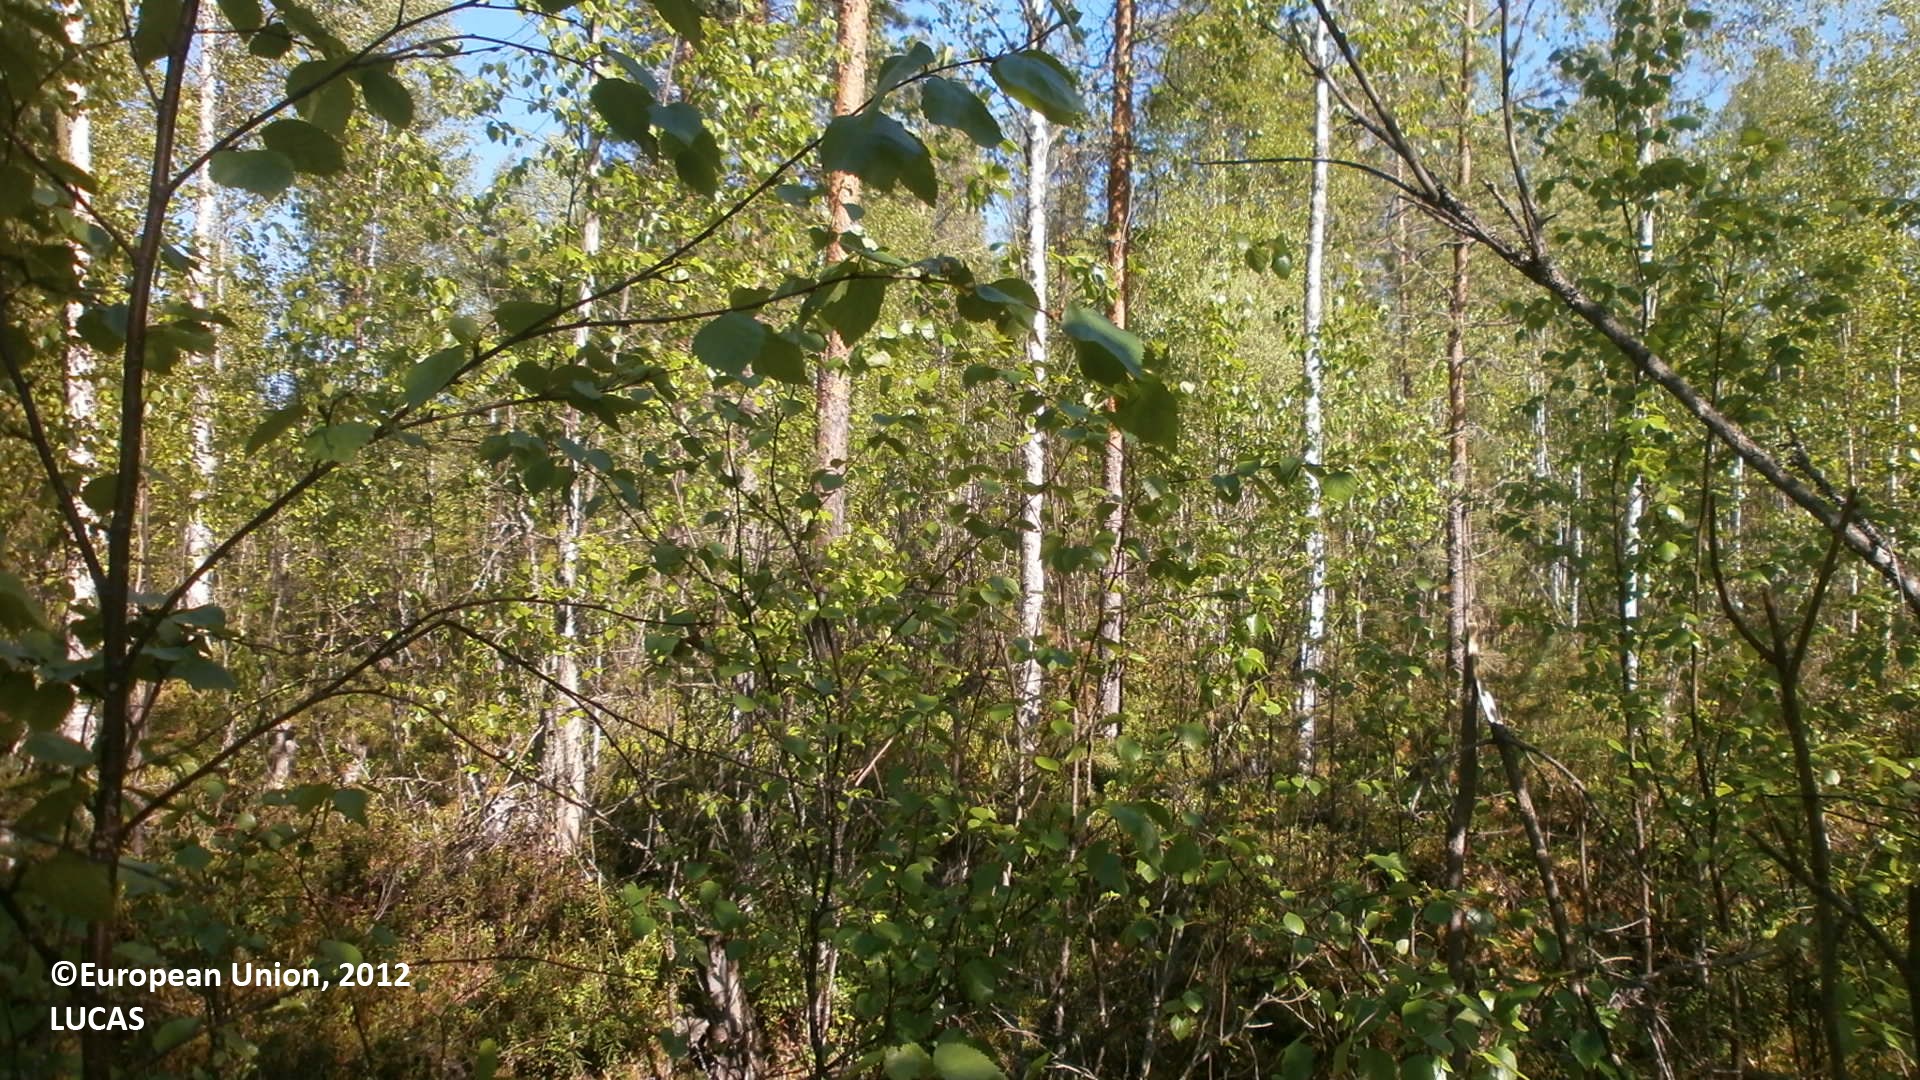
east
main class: Woodland
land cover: Broadleaved woodland
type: mire and swamp forests
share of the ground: 50 - 75 %
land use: Forestry
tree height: > 5 m
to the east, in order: Broadleaved woodland; Ditches and canals; Broadleaved woodland; Ditches and canals; Broadleaved woodland; Ditches and canals; Broadleaved woodland; Ditches and canals; Broadleaved woodland; Ditches and canals; Broadleaved woodland; Ditches and canals; Broadleaved woodland; Ditches and canals; Broadleaved woodland; Ditches and canals; Broadleaved woodland; Shrubland with sparse tree cover; Broadleaved woodland; Ditches and canals; Broadleaved woodland; Ditches and canals; Broadleaved woodland; Other mixed woodland; Ditches and canals; Pine dominated mixed woodland
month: June
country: FI
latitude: 64.1379
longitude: 25.7782
